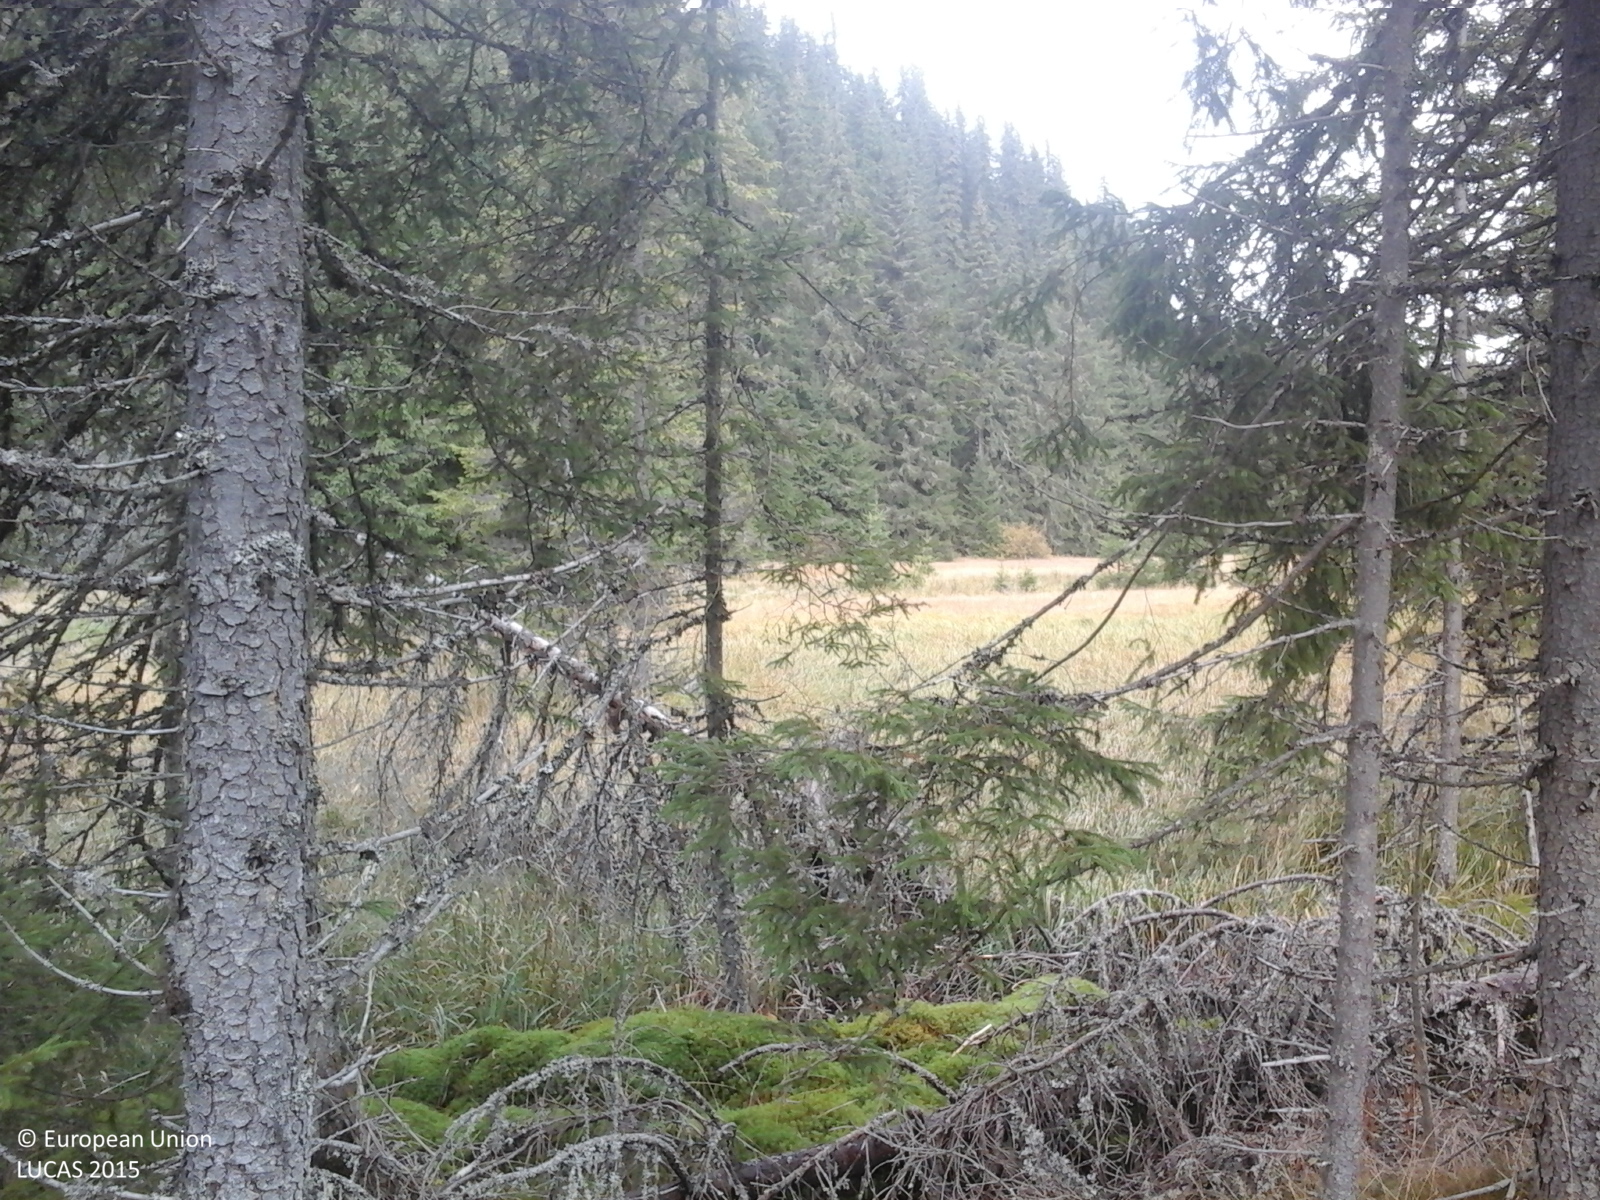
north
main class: Woodland
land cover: Spruce dominated coniferous woodland
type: alpine coniferous forest
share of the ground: > 75 %
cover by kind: coniferous forest trees 100 %
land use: Forestry
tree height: > 5 m
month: September
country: RO
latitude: 46.5344
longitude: 23.0333
